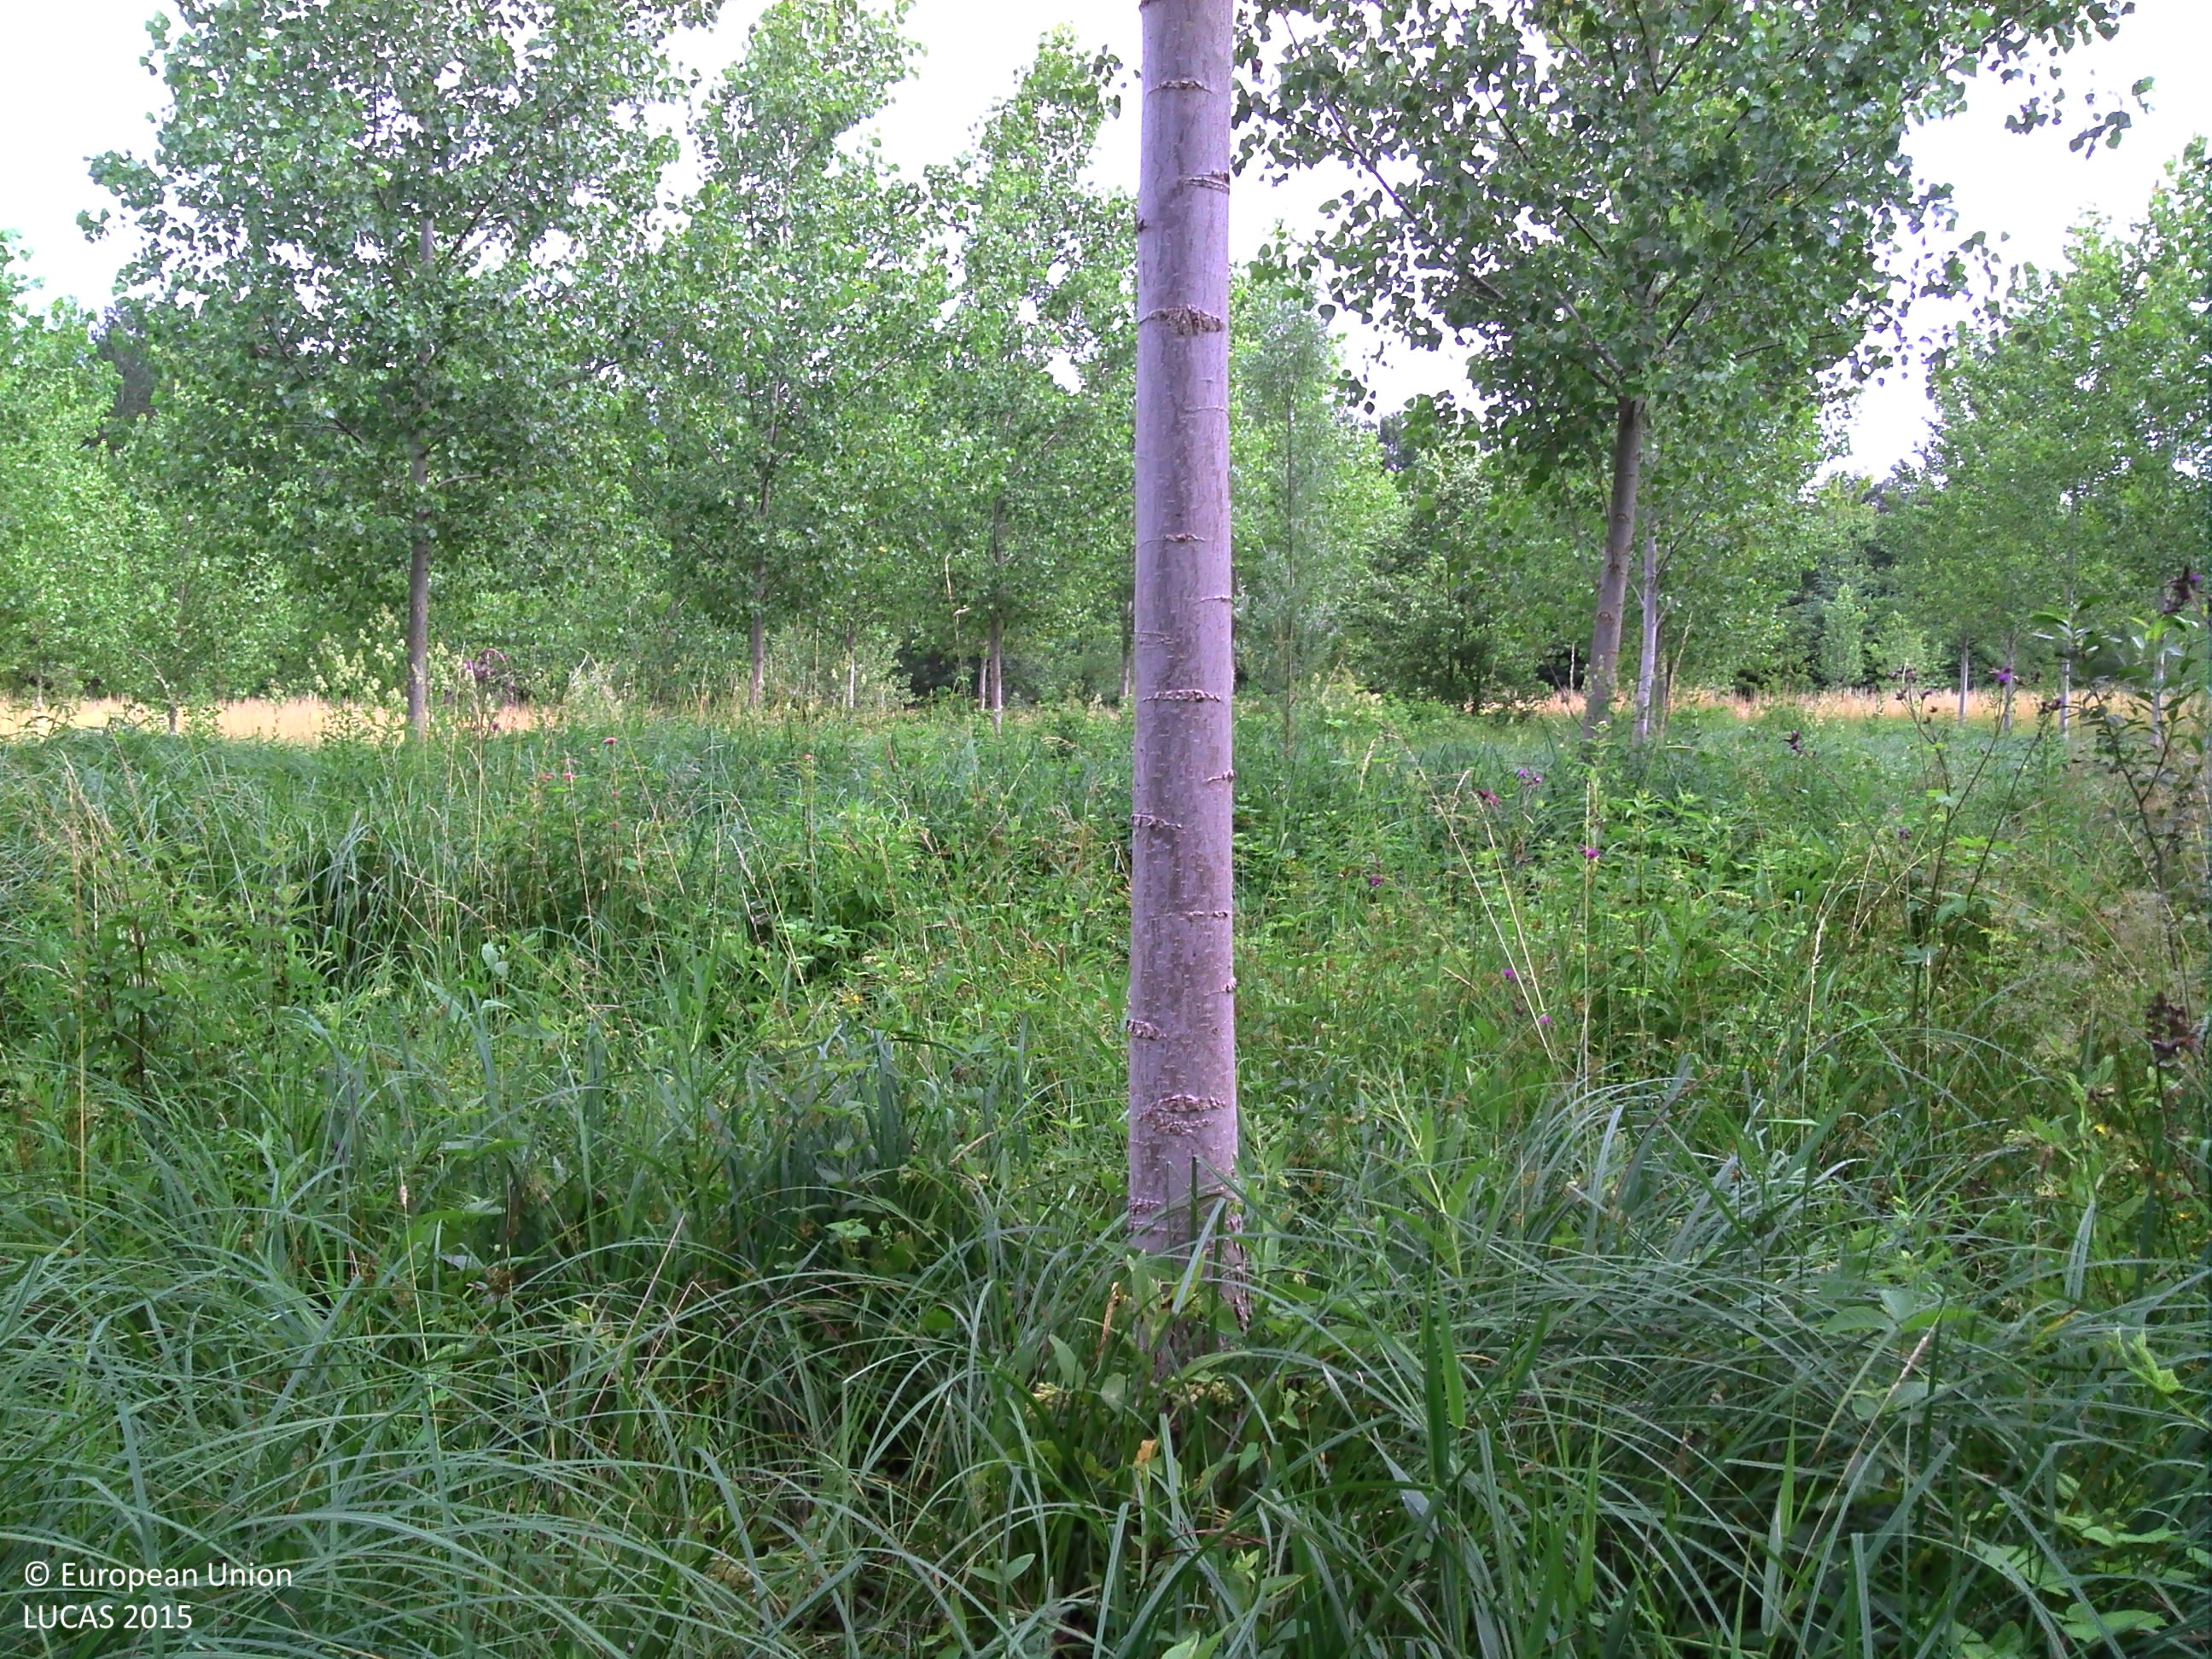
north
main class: Woodland
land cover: Broadleaved woodland
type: floodplain forest
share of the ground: 50 - 75 %
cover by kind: broadleaved forest trees 50 %, herbaceous plants 50 %
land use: Forestry
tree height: > 5 m
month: July
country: BE
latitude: 51.2463
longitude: 5.4568
